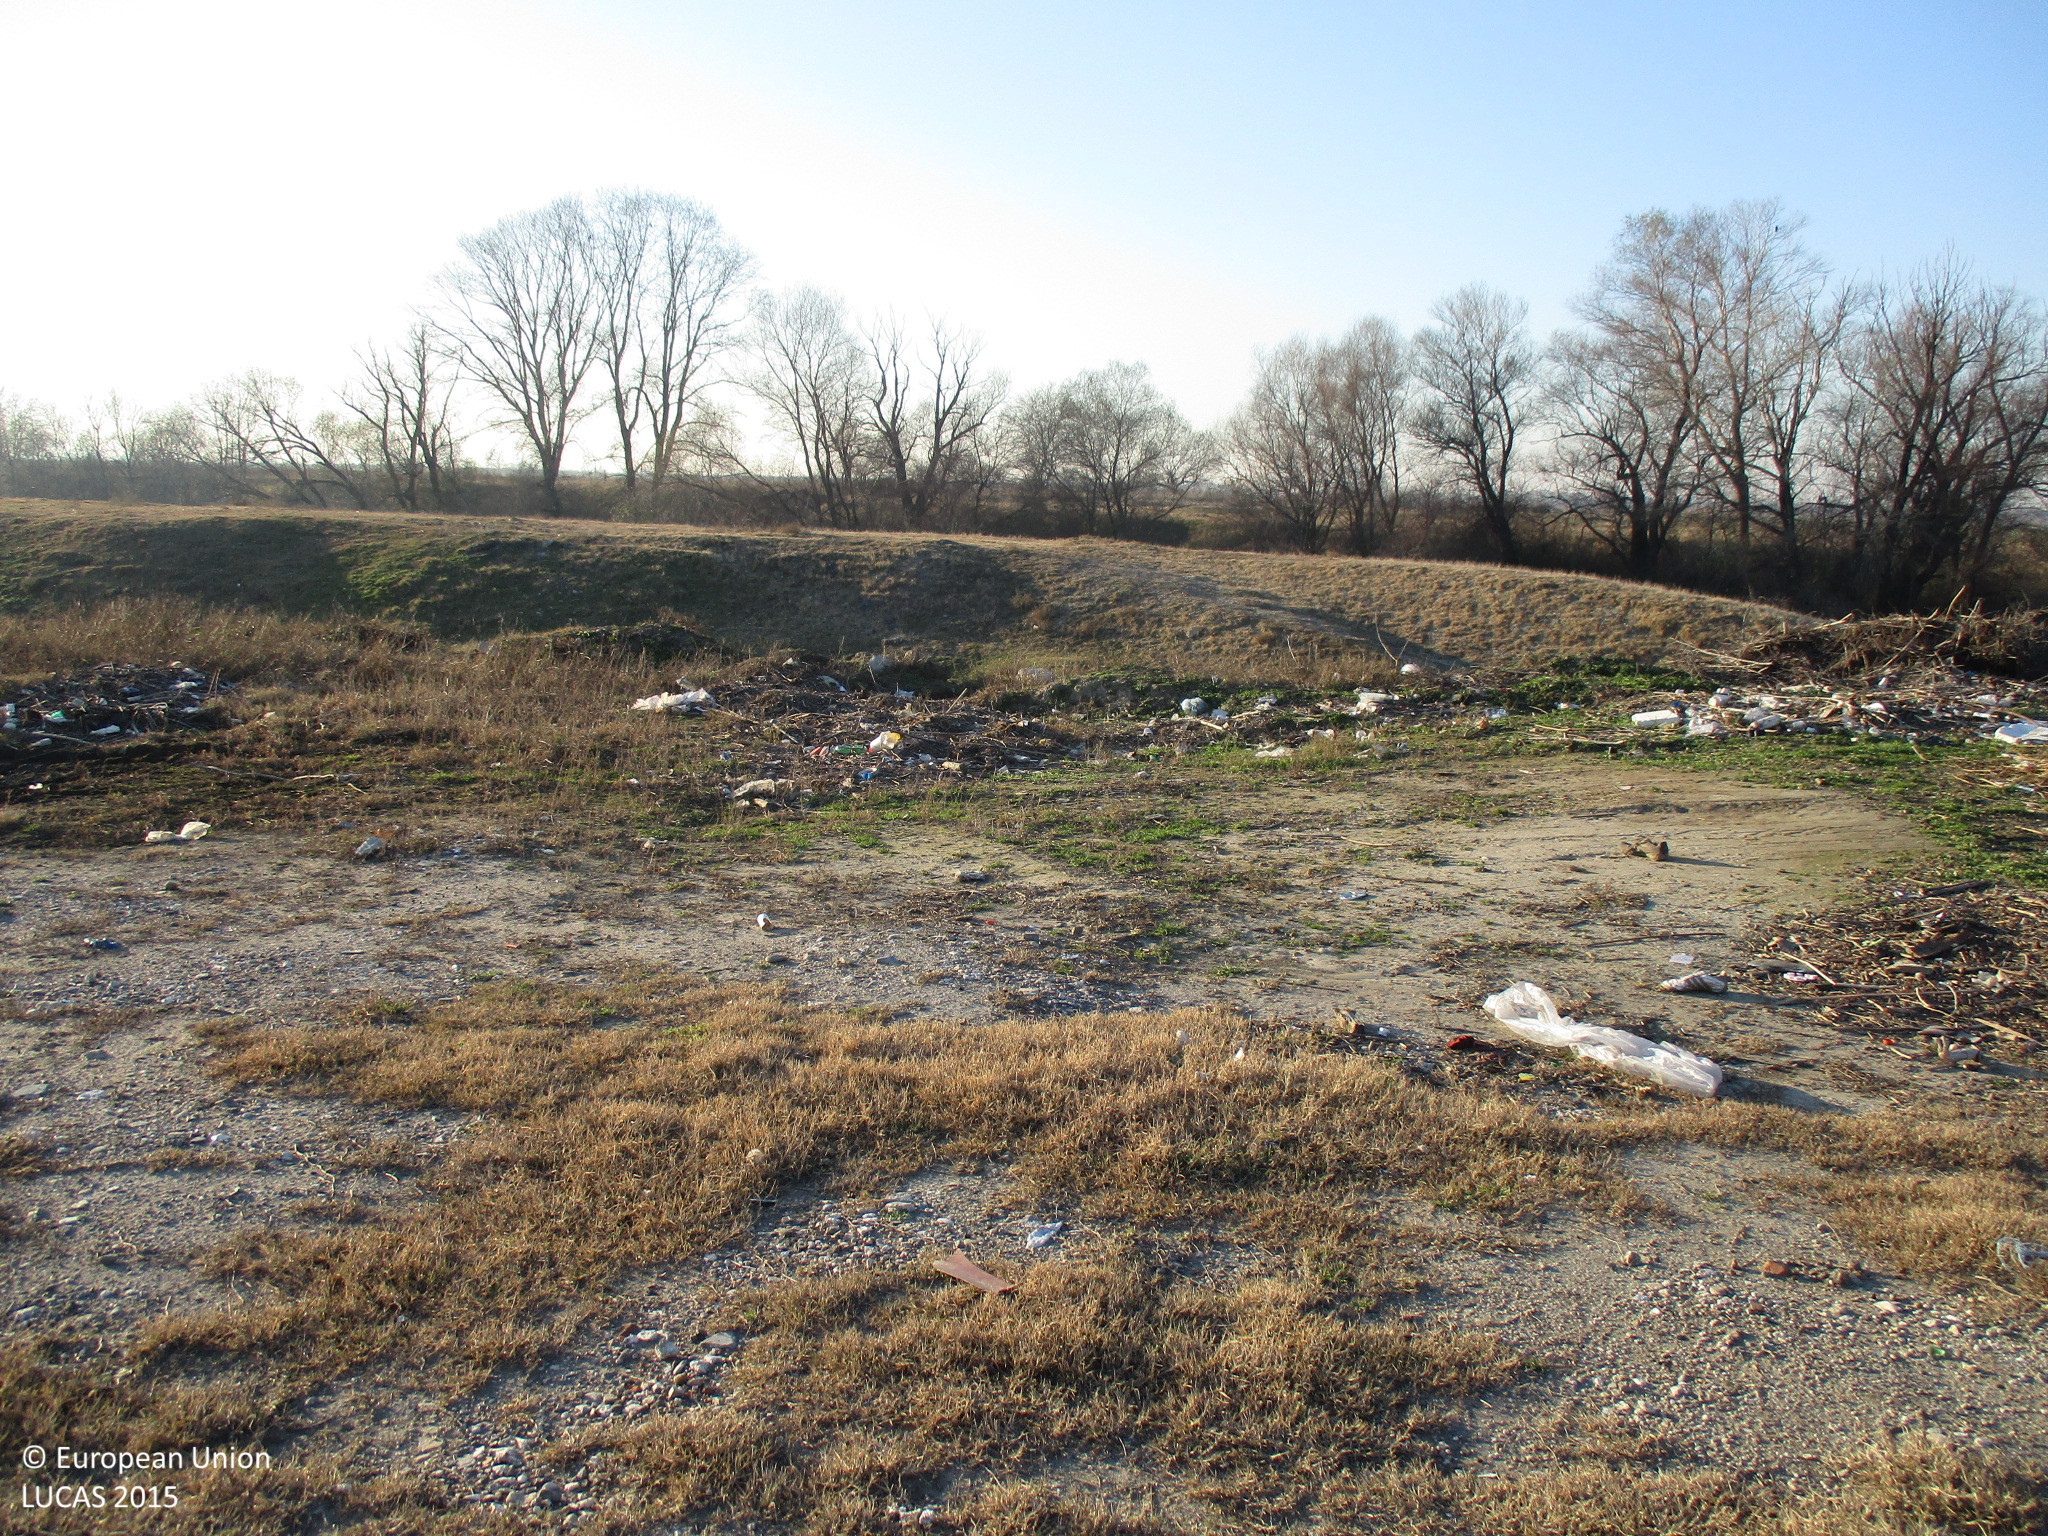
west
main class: Grassland
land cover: Grassland without tree/shrub cover
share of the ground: > 75 %
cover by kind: herbaceous plants 100 %
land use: Agriculture (excluding fallow land and kitchen gardens)
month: December
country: BG
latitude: 42.1387
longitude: 24.6040
